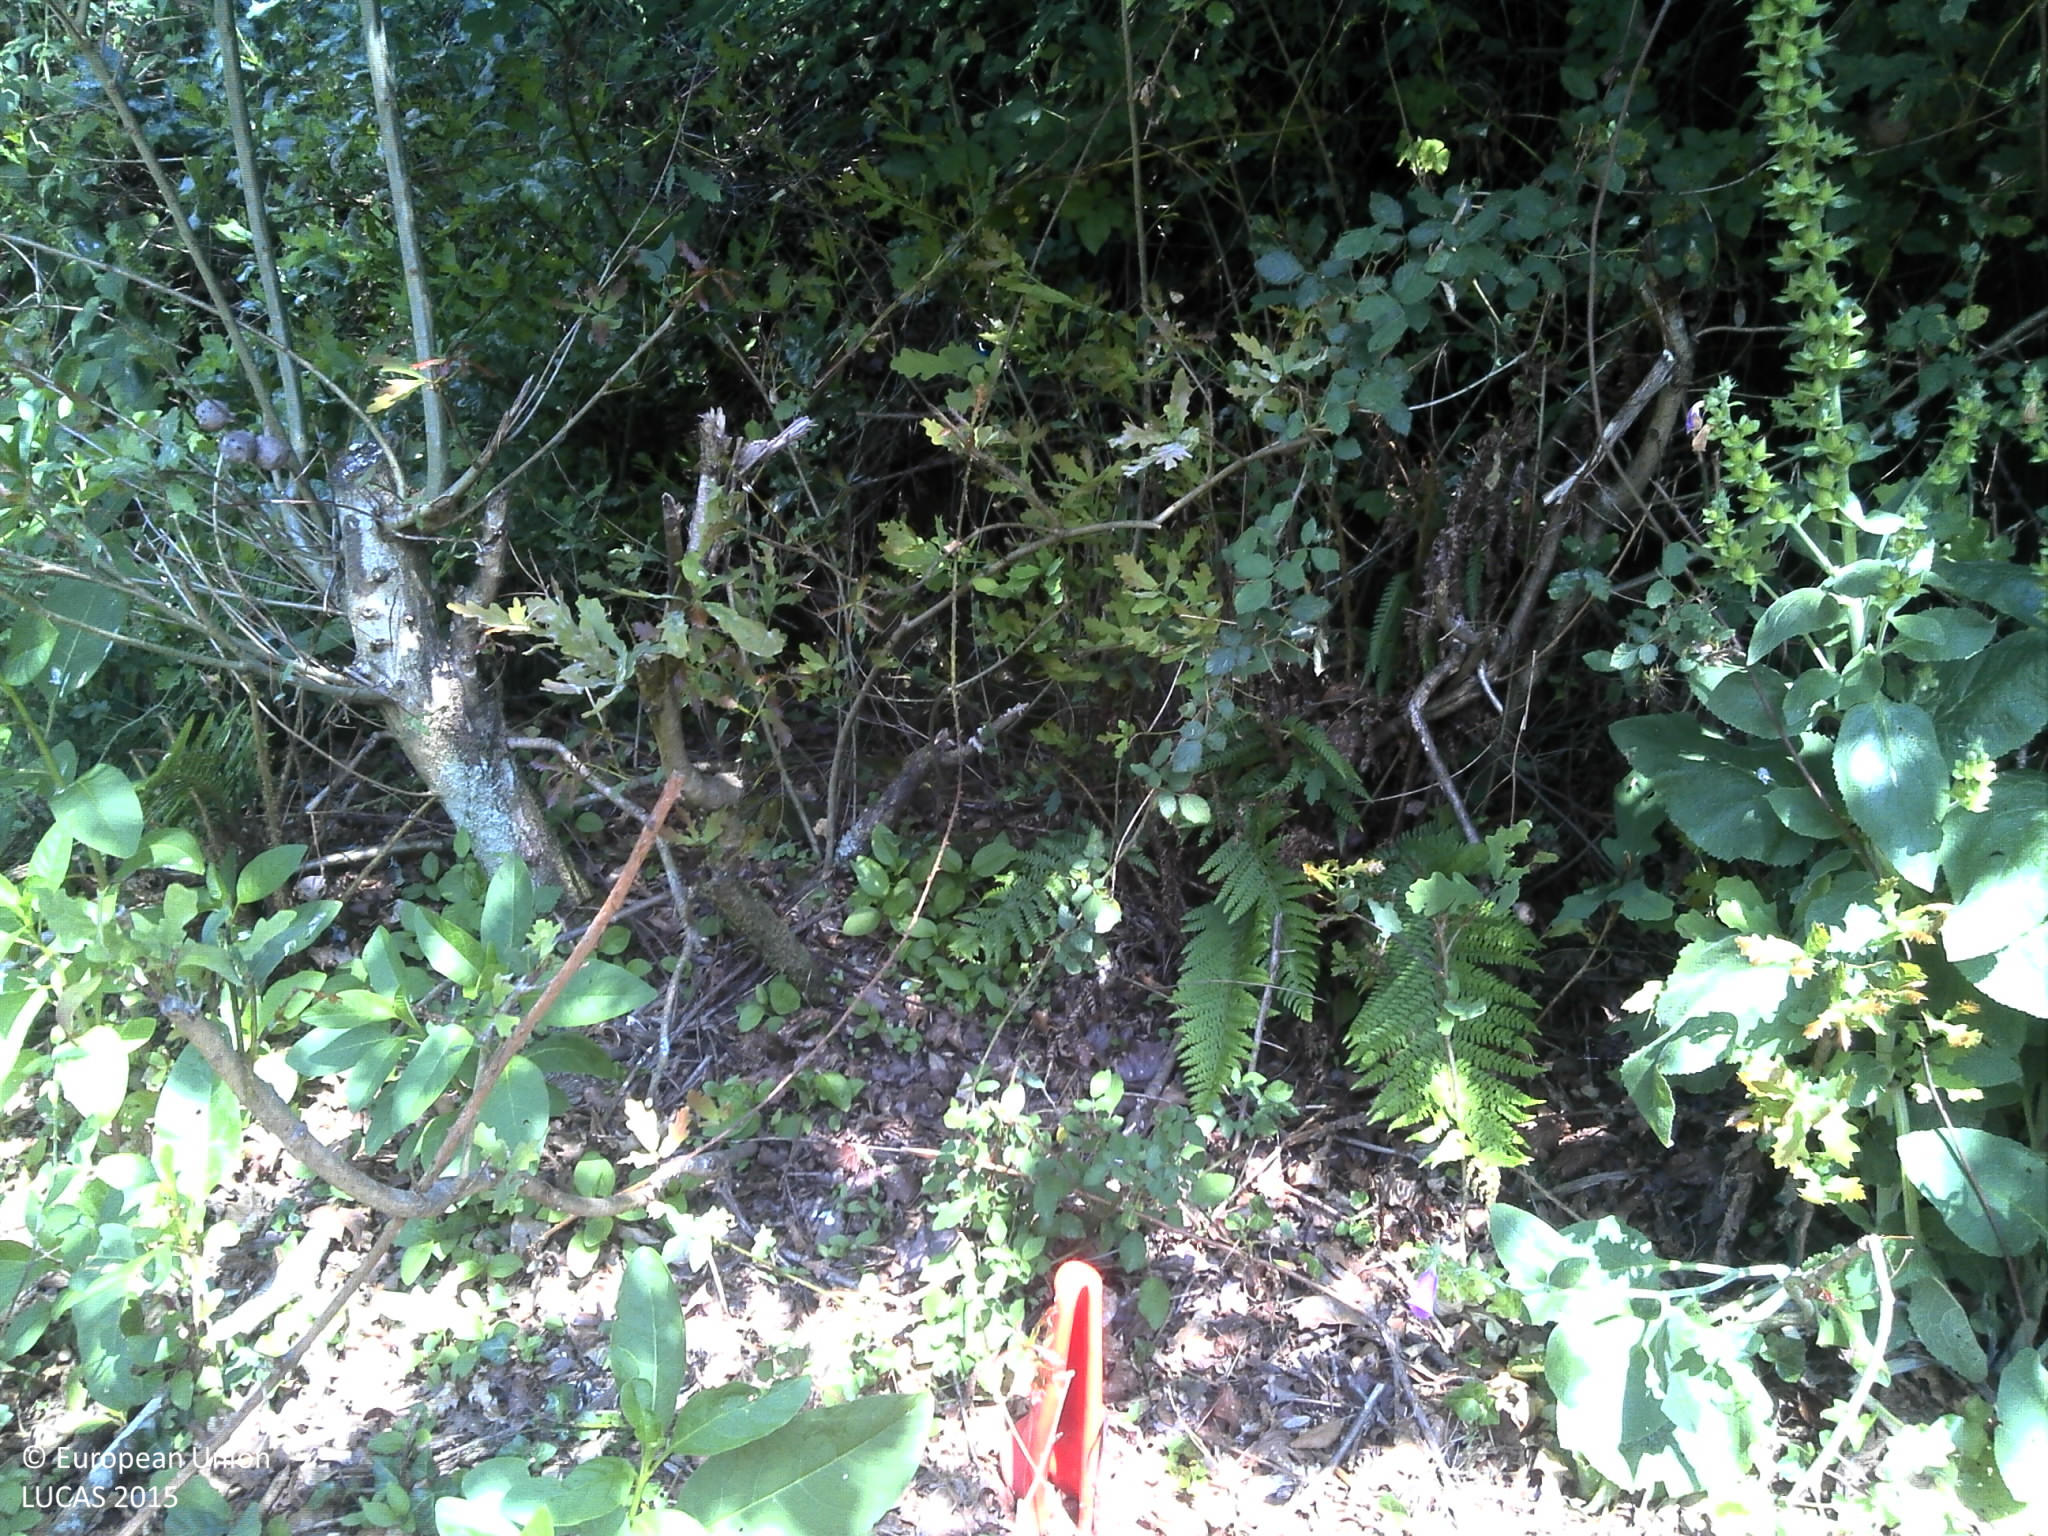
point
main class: Woodland
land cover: Broadleaved woodland
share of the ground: 25 - 50 %
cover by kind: broadleaved forest trees 50 %, shrubs 30 %, consolidated bare surface 10 %, unconsolidated bare surface 10 %
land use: Semi-natural and natural areas not in use
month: June
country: PT
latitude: 40.6794
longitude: -8.2721
